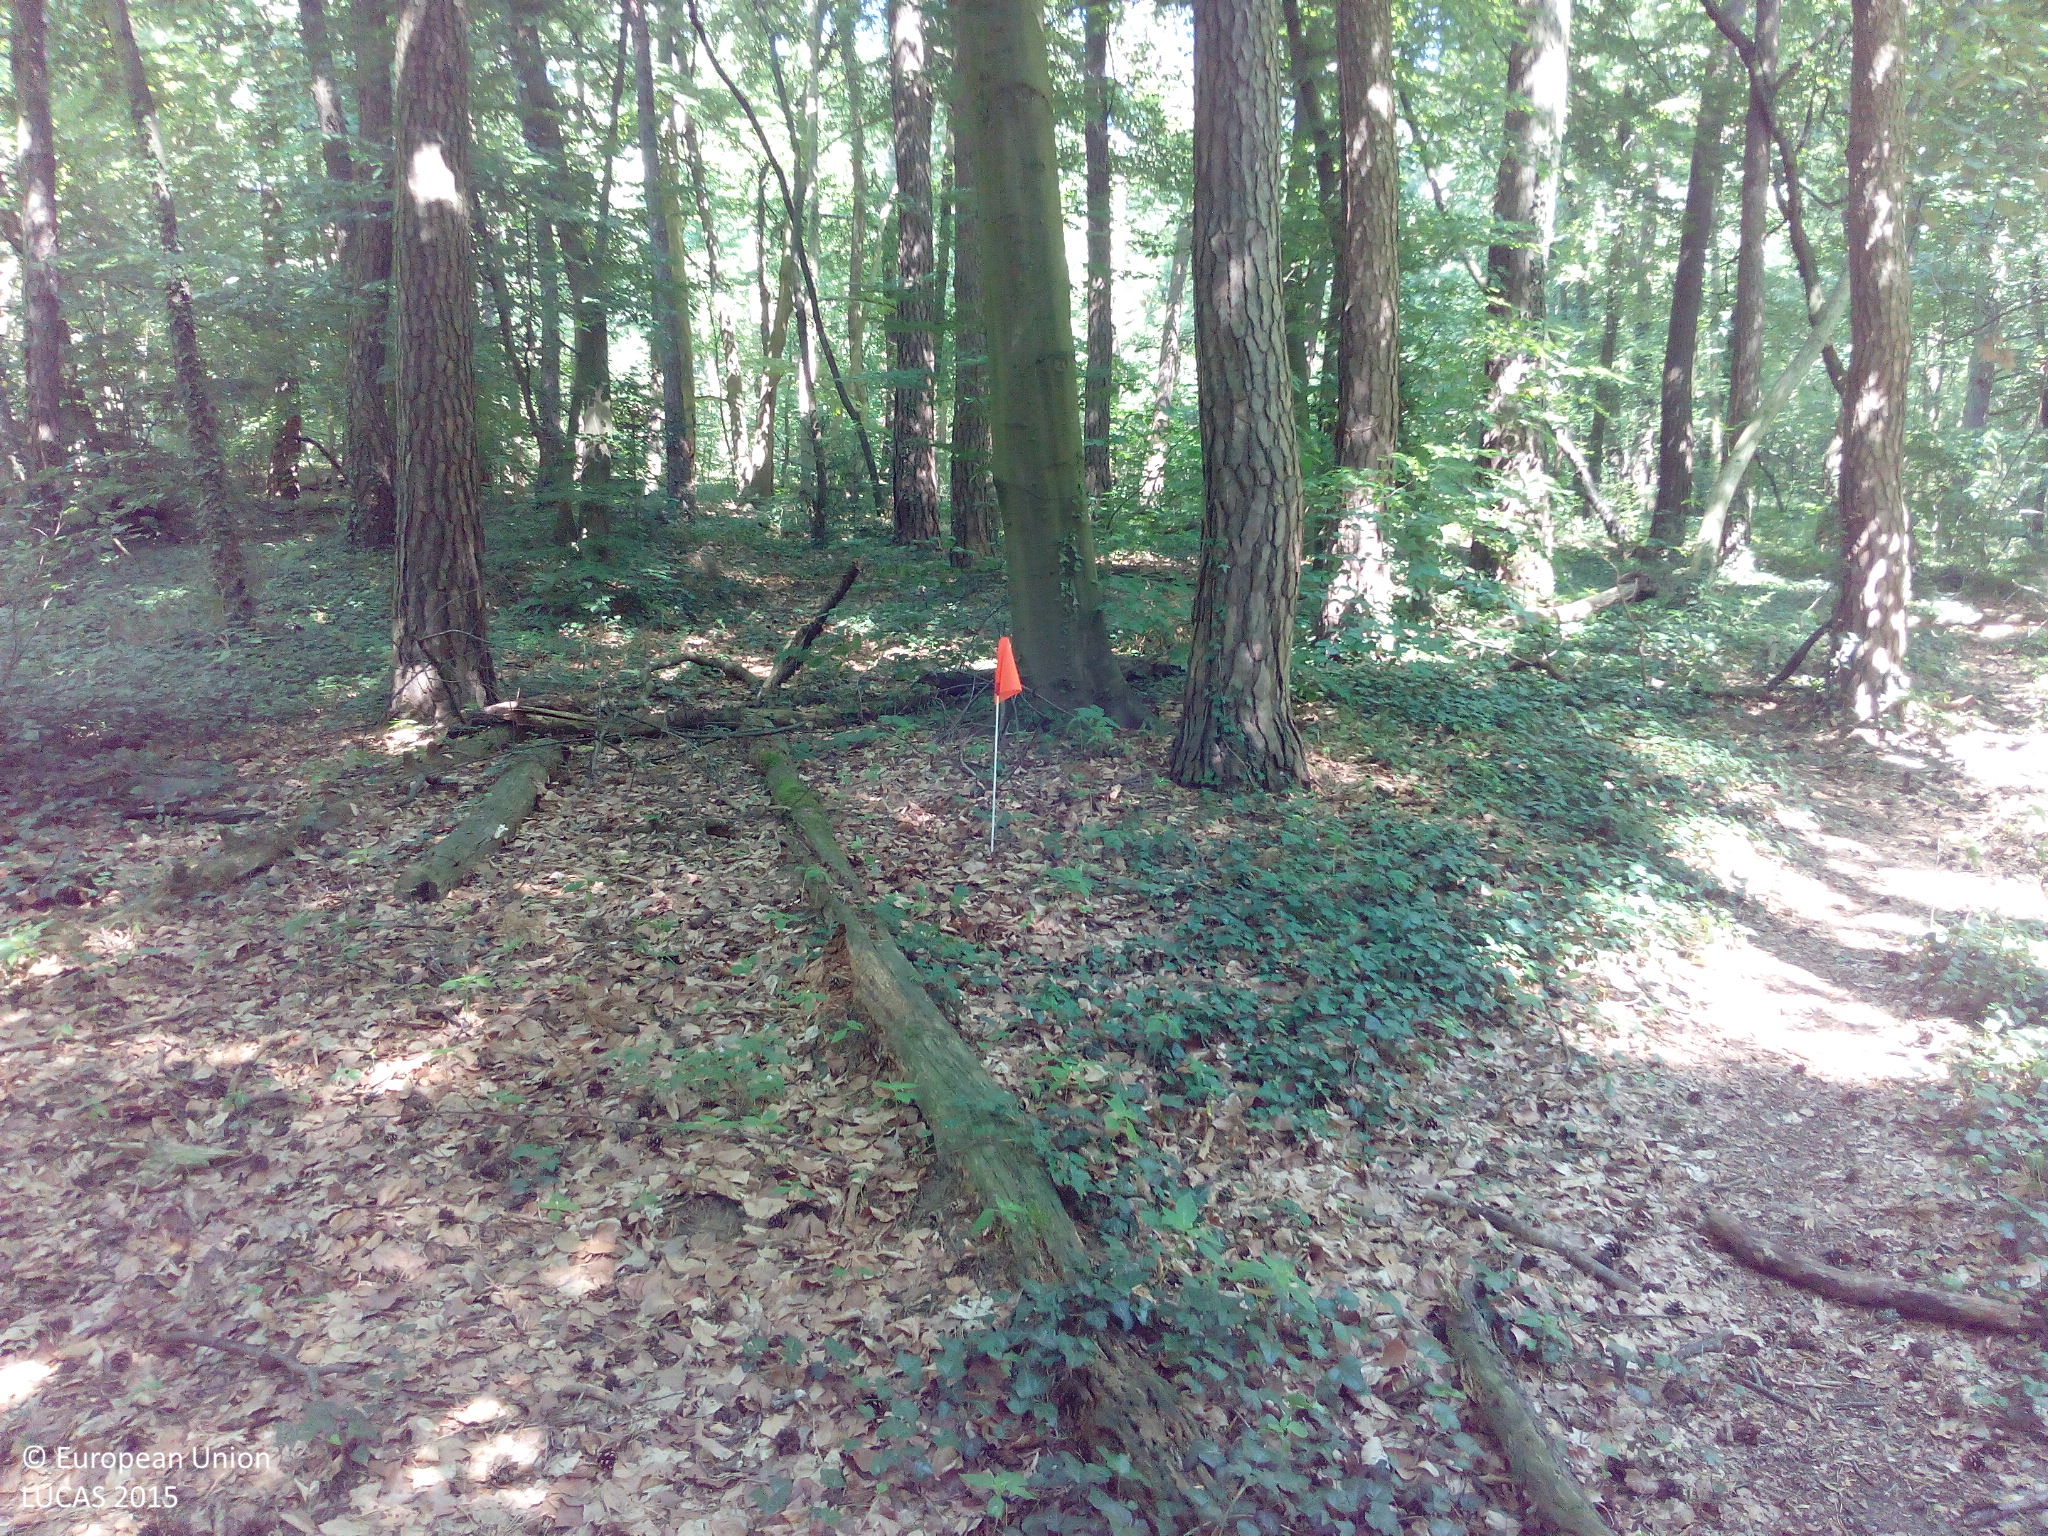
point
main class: Woodland
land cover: Pine dominated mixed woodland
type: mesophytic deciduous forest
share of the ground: > 75 %
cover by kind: broadleaved forest trees 50 %, coniferous forest trees 30 %, herbaceous plants 10 %, unconsolidated bare surface 10 %
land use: Forestry
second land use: Amenities, museums, leisure
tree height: > 5 m
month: July
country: DE
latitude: 49.8345
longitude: 8.6518
